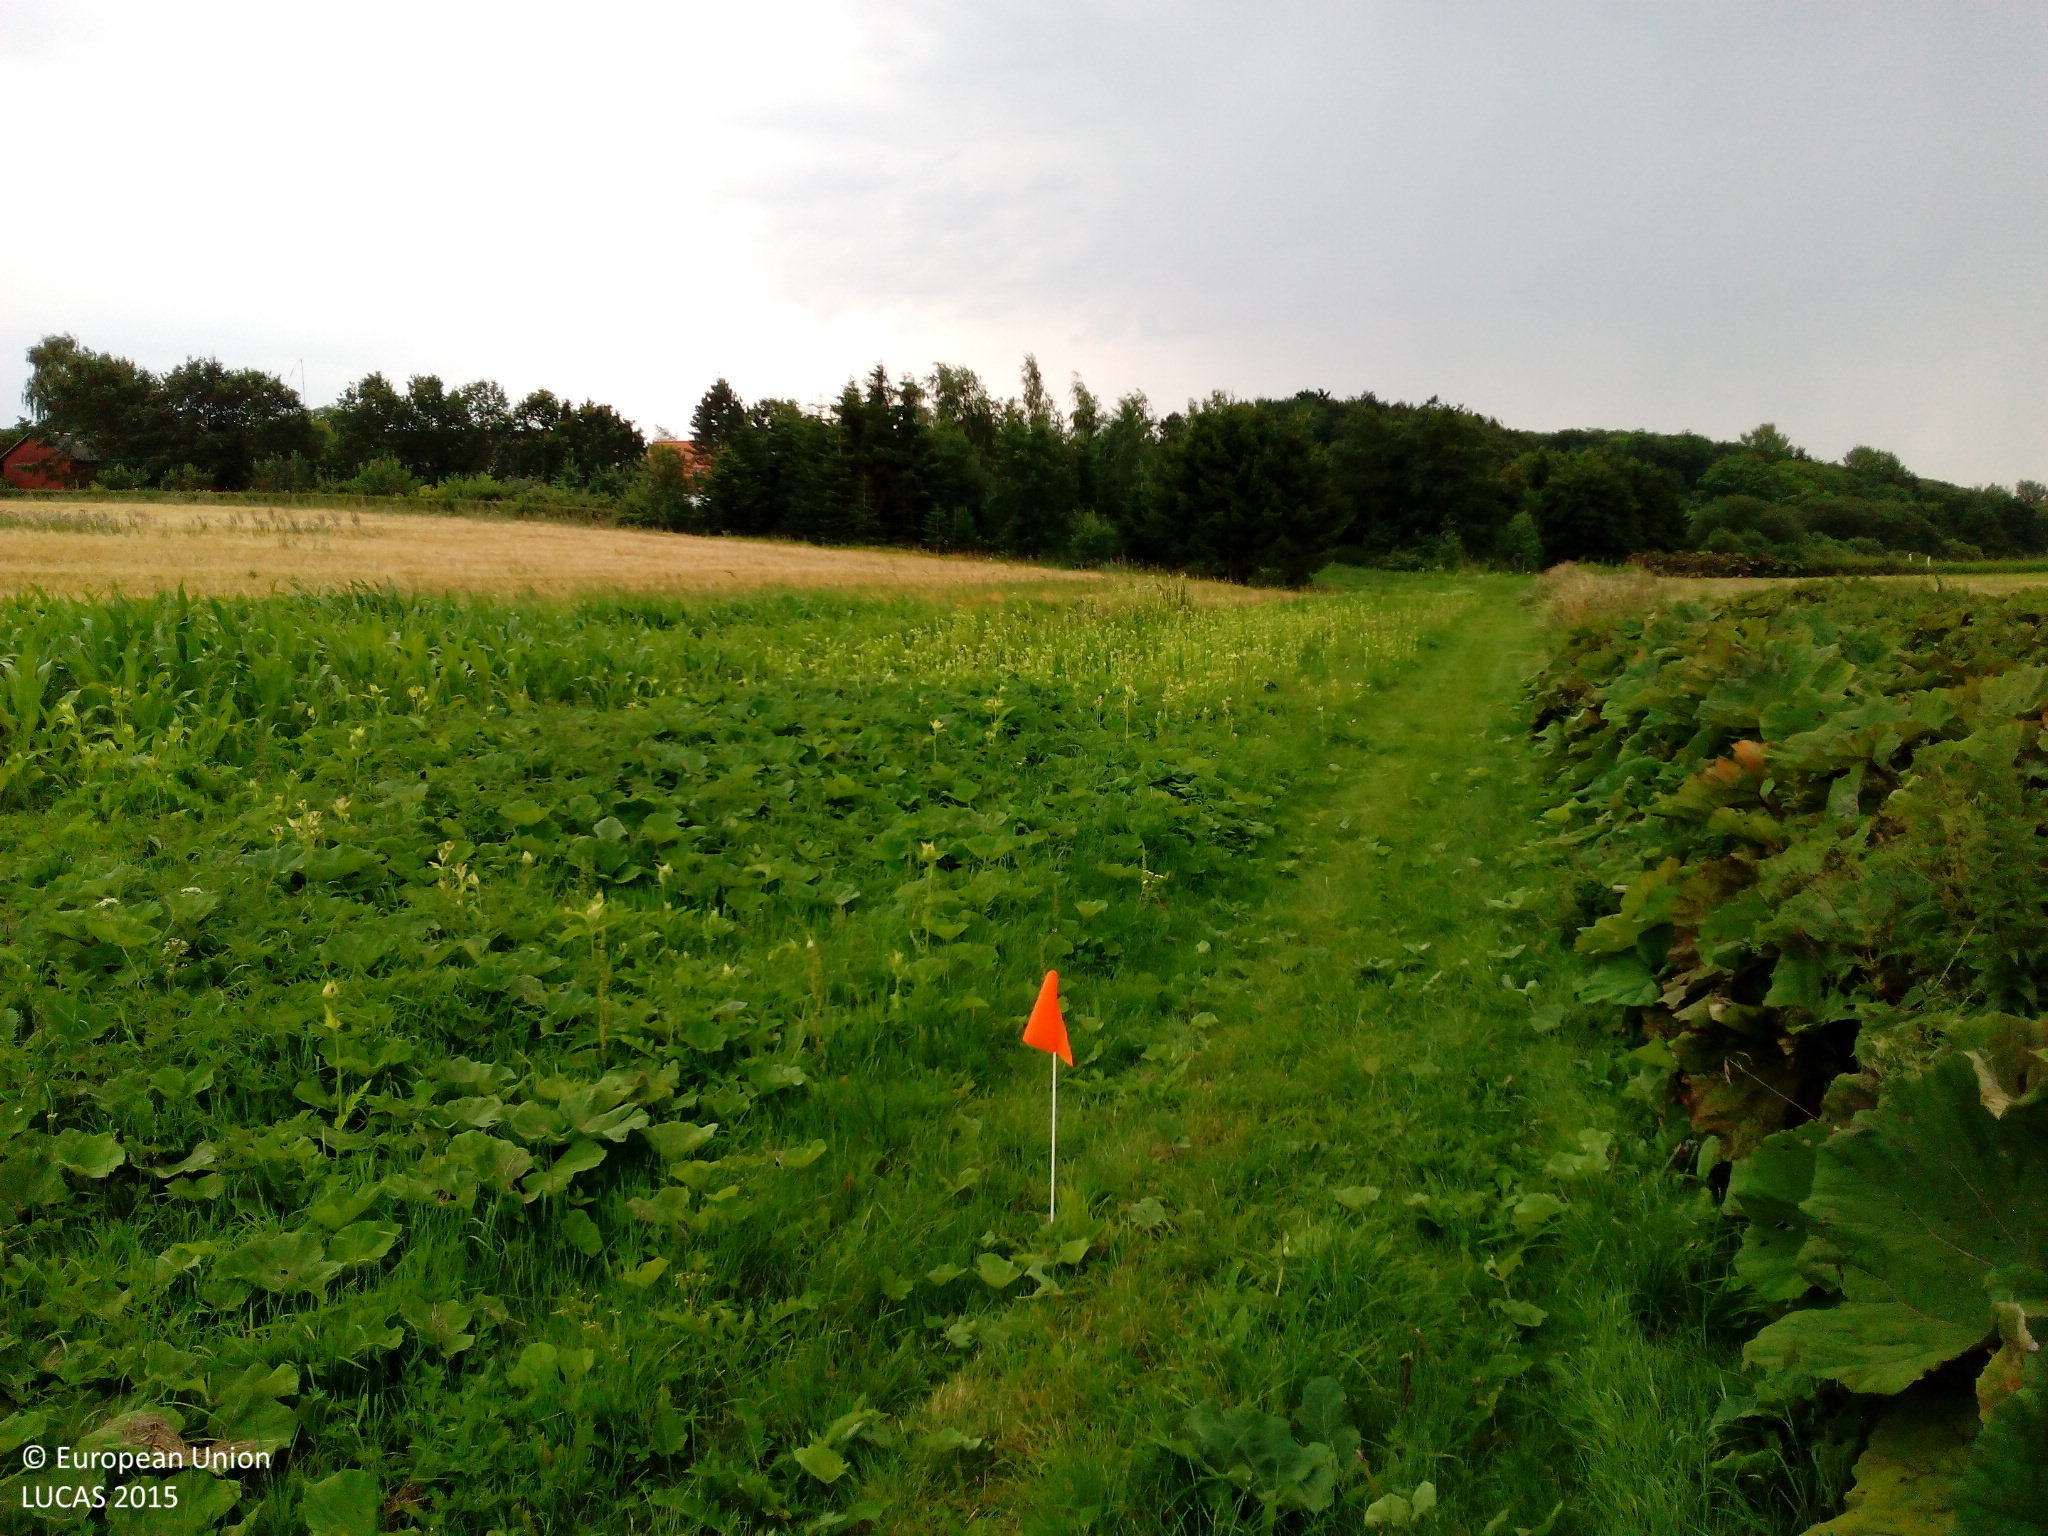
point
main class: Grassland
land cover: Grassland without tree/shrub cover
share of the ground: > 75 %
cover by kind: herbaceous plants 100 %
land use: Semi-natural and natural areas not in use
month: August
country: DK
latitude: 55.5252
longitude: 11.9785
